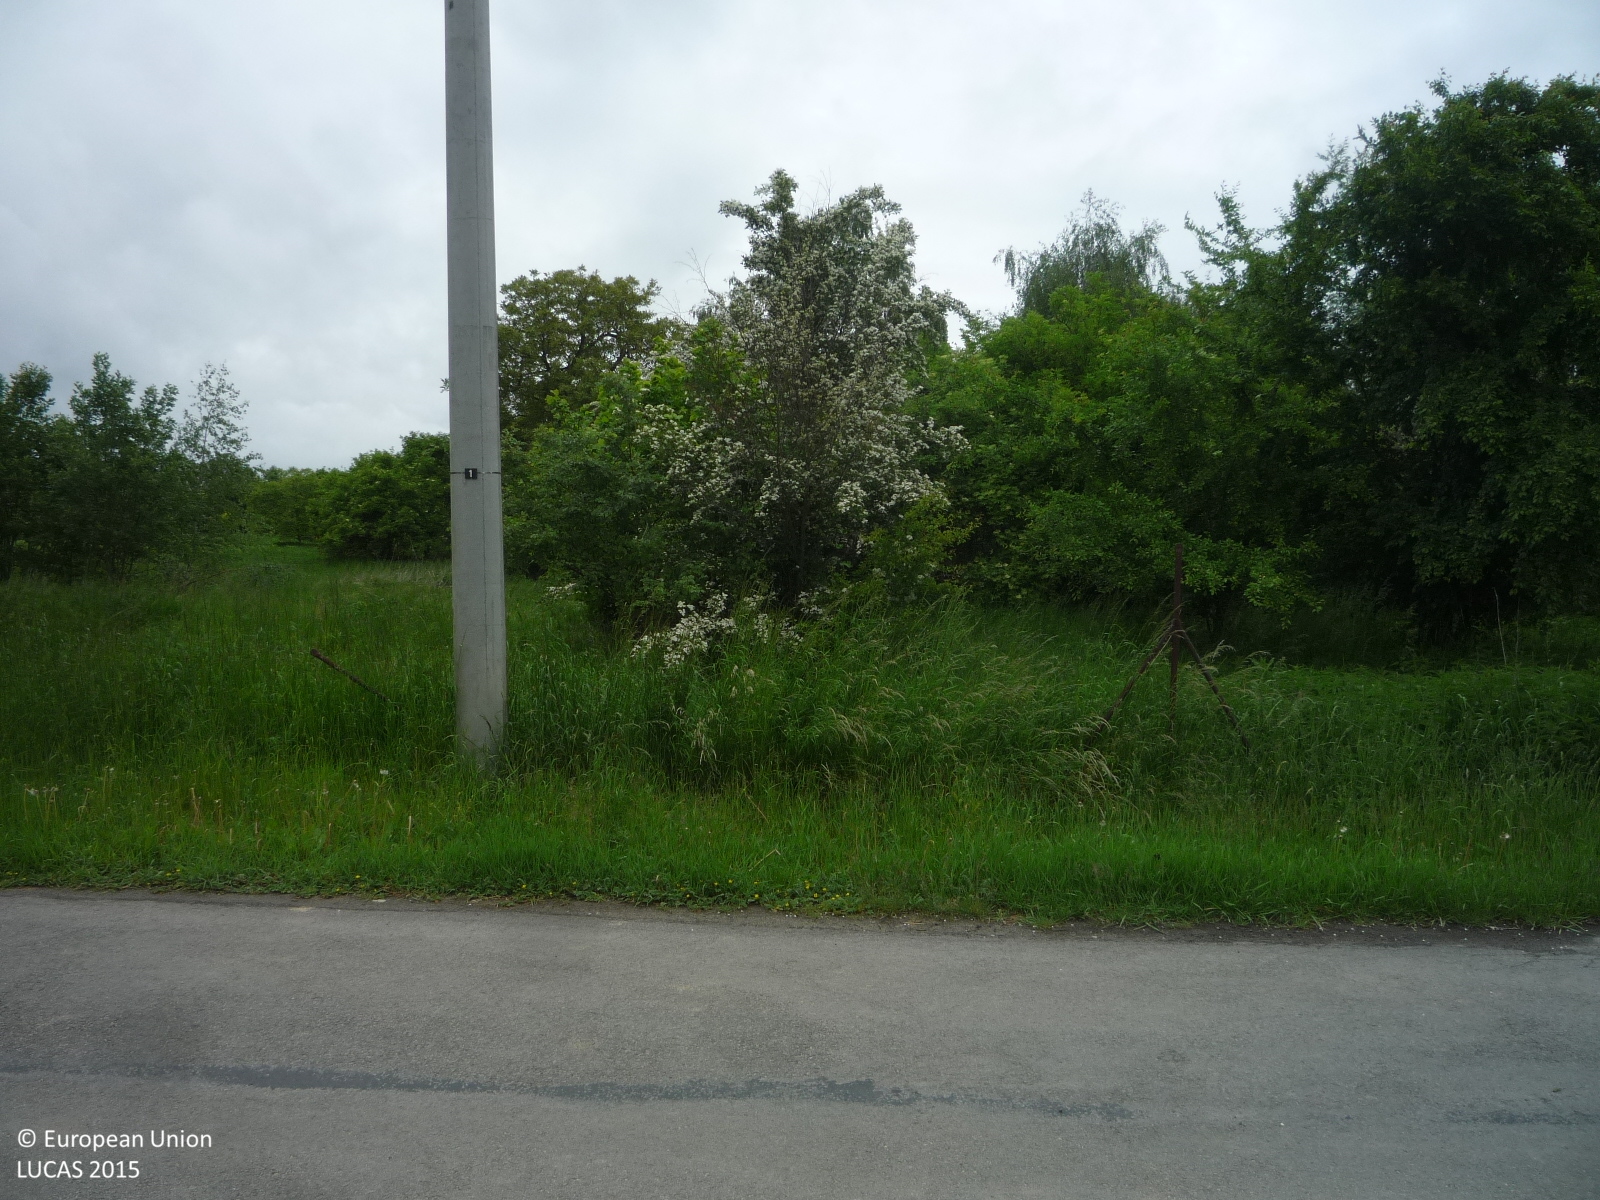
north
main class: Grassland
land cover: Grassland without tree/shrub cover
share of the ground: > 75 %
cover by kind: herbaceous plants 100 %
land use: Residential
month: May
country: CZ
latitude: 50.4121
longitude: 14.6882
